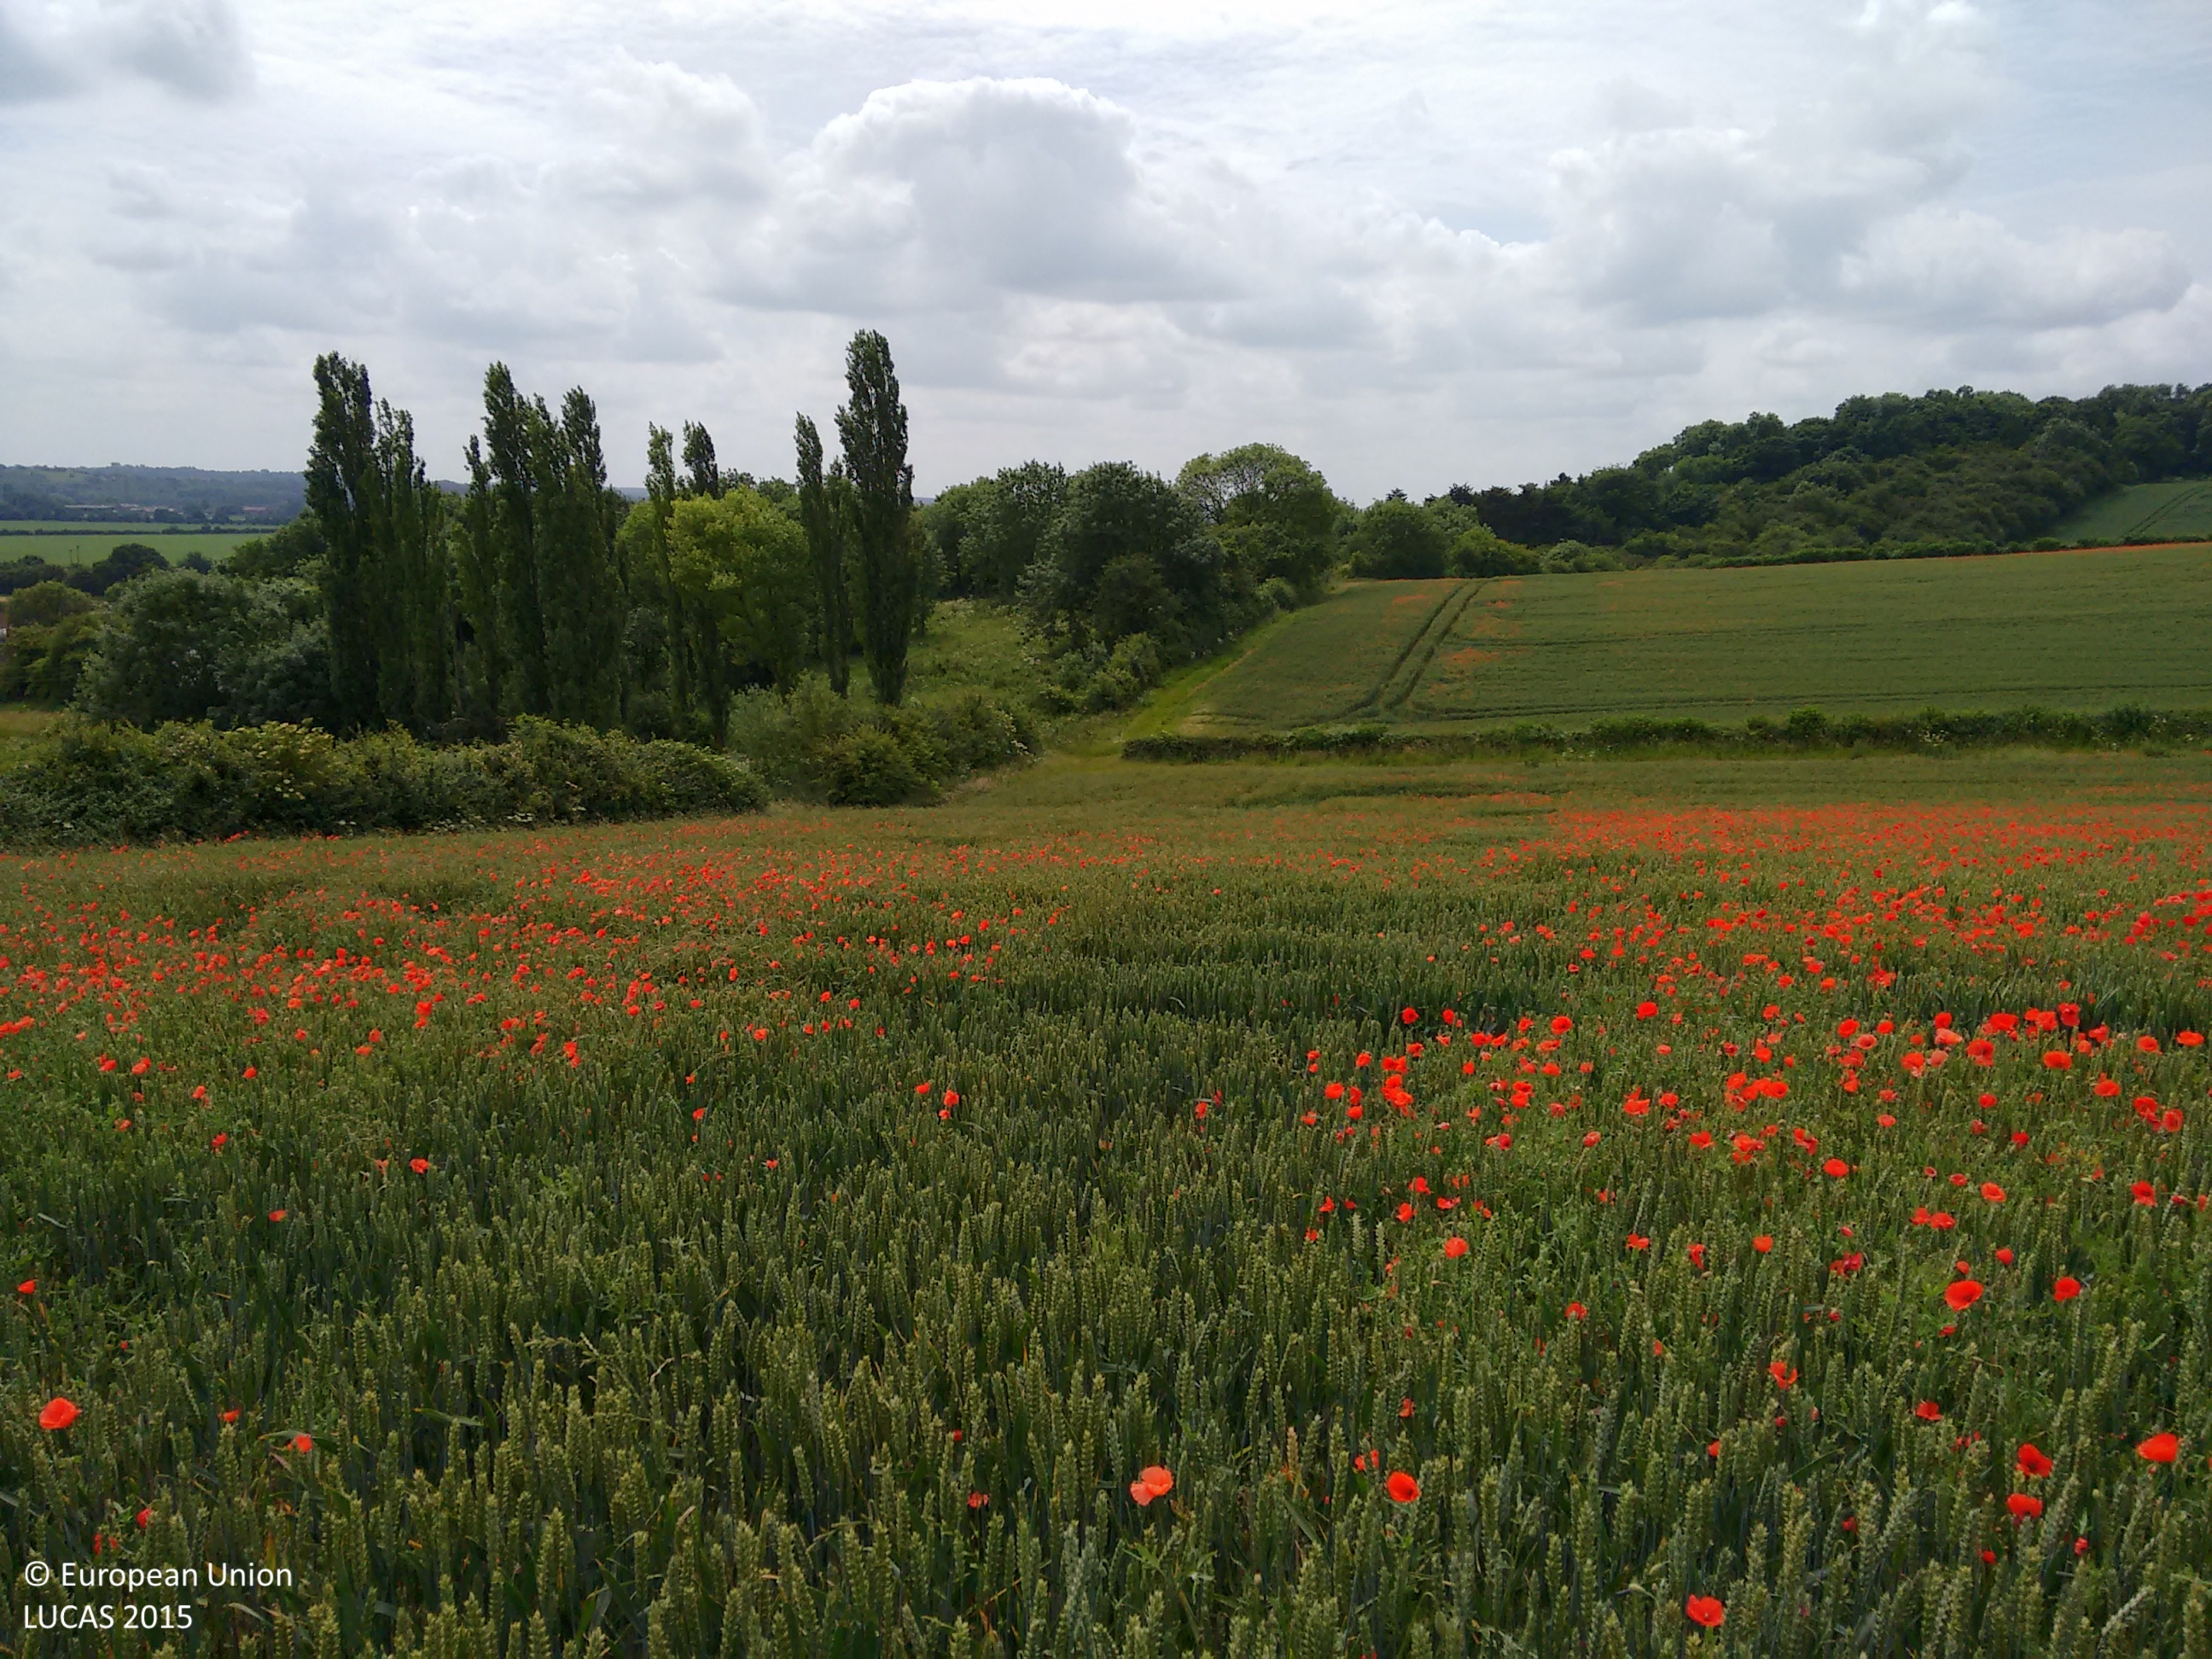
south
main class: Cropland
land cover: Common wheat
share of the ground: > 75 %
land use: Agriculture (excluding fallow land and kitchen gardens)
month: June
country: GB
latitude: 52.9851
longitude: -1.0523
